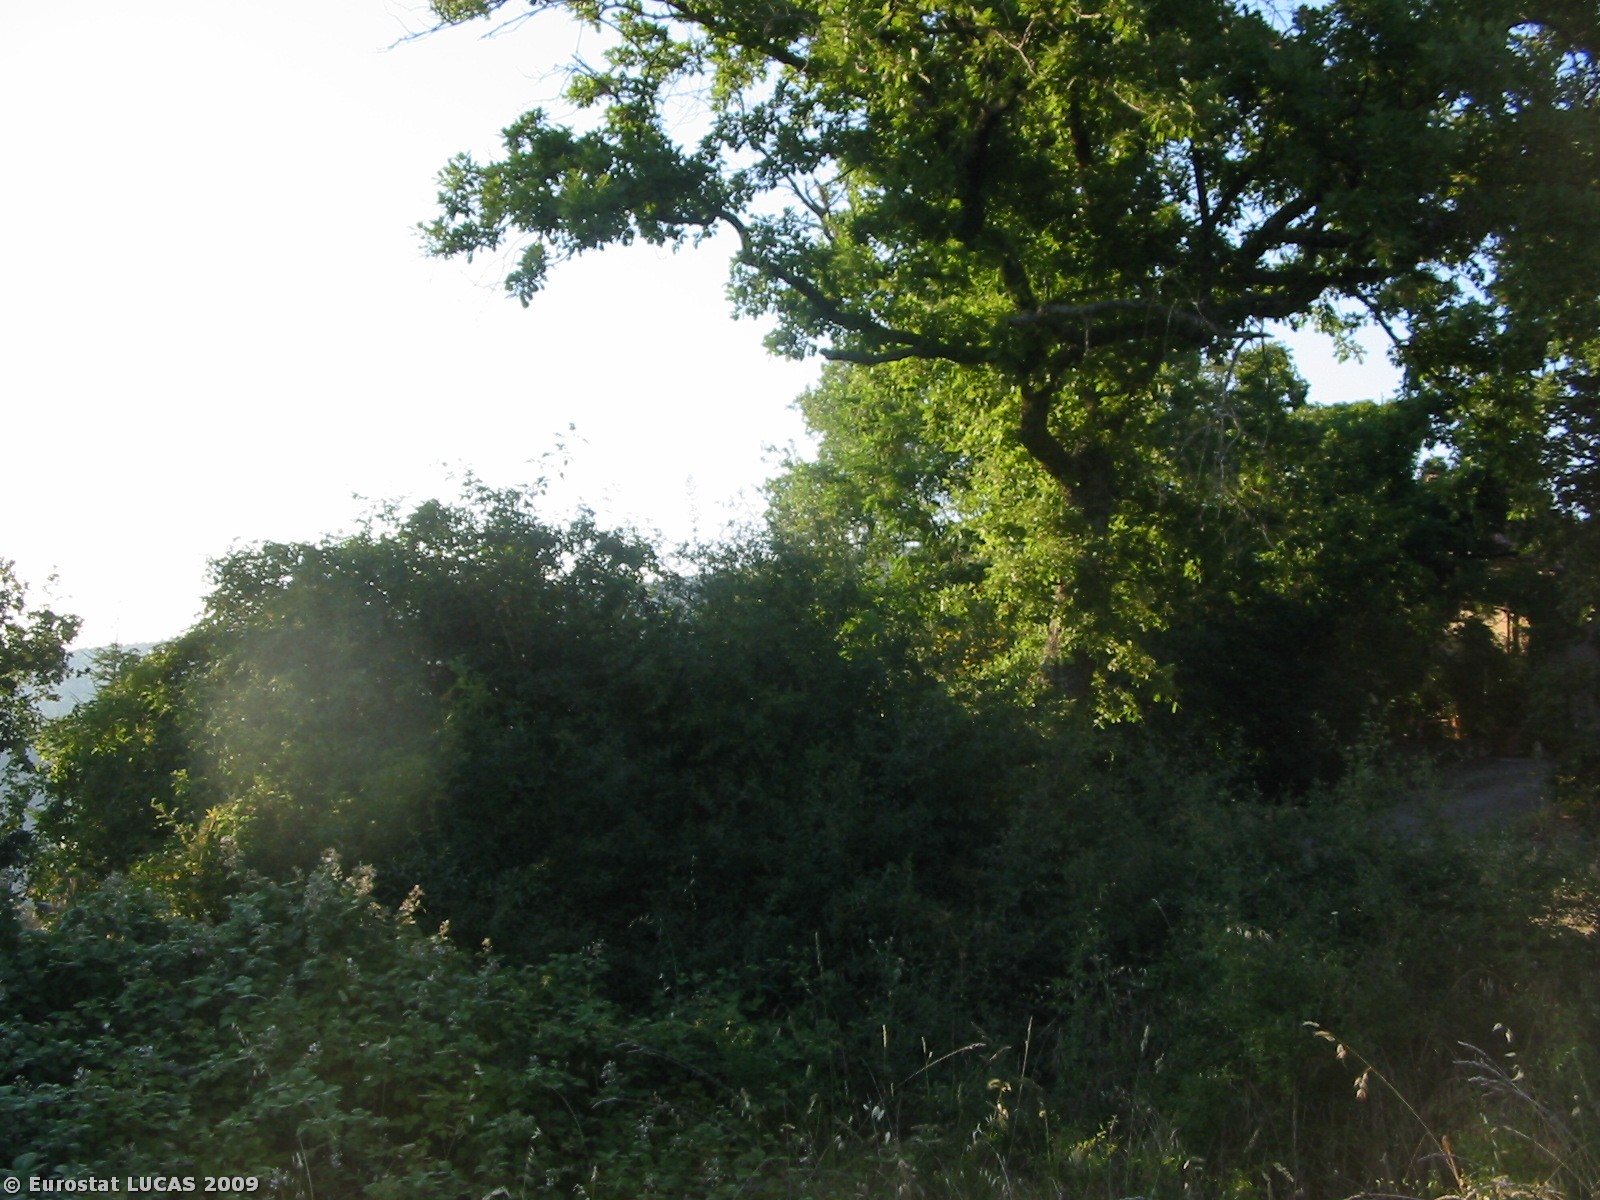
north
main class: Shrubland
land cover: Shrubland with sparse tree cover
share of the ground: > 75 %
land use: Unused
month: June
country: IT
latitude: 43.2844
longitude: 12.0031
